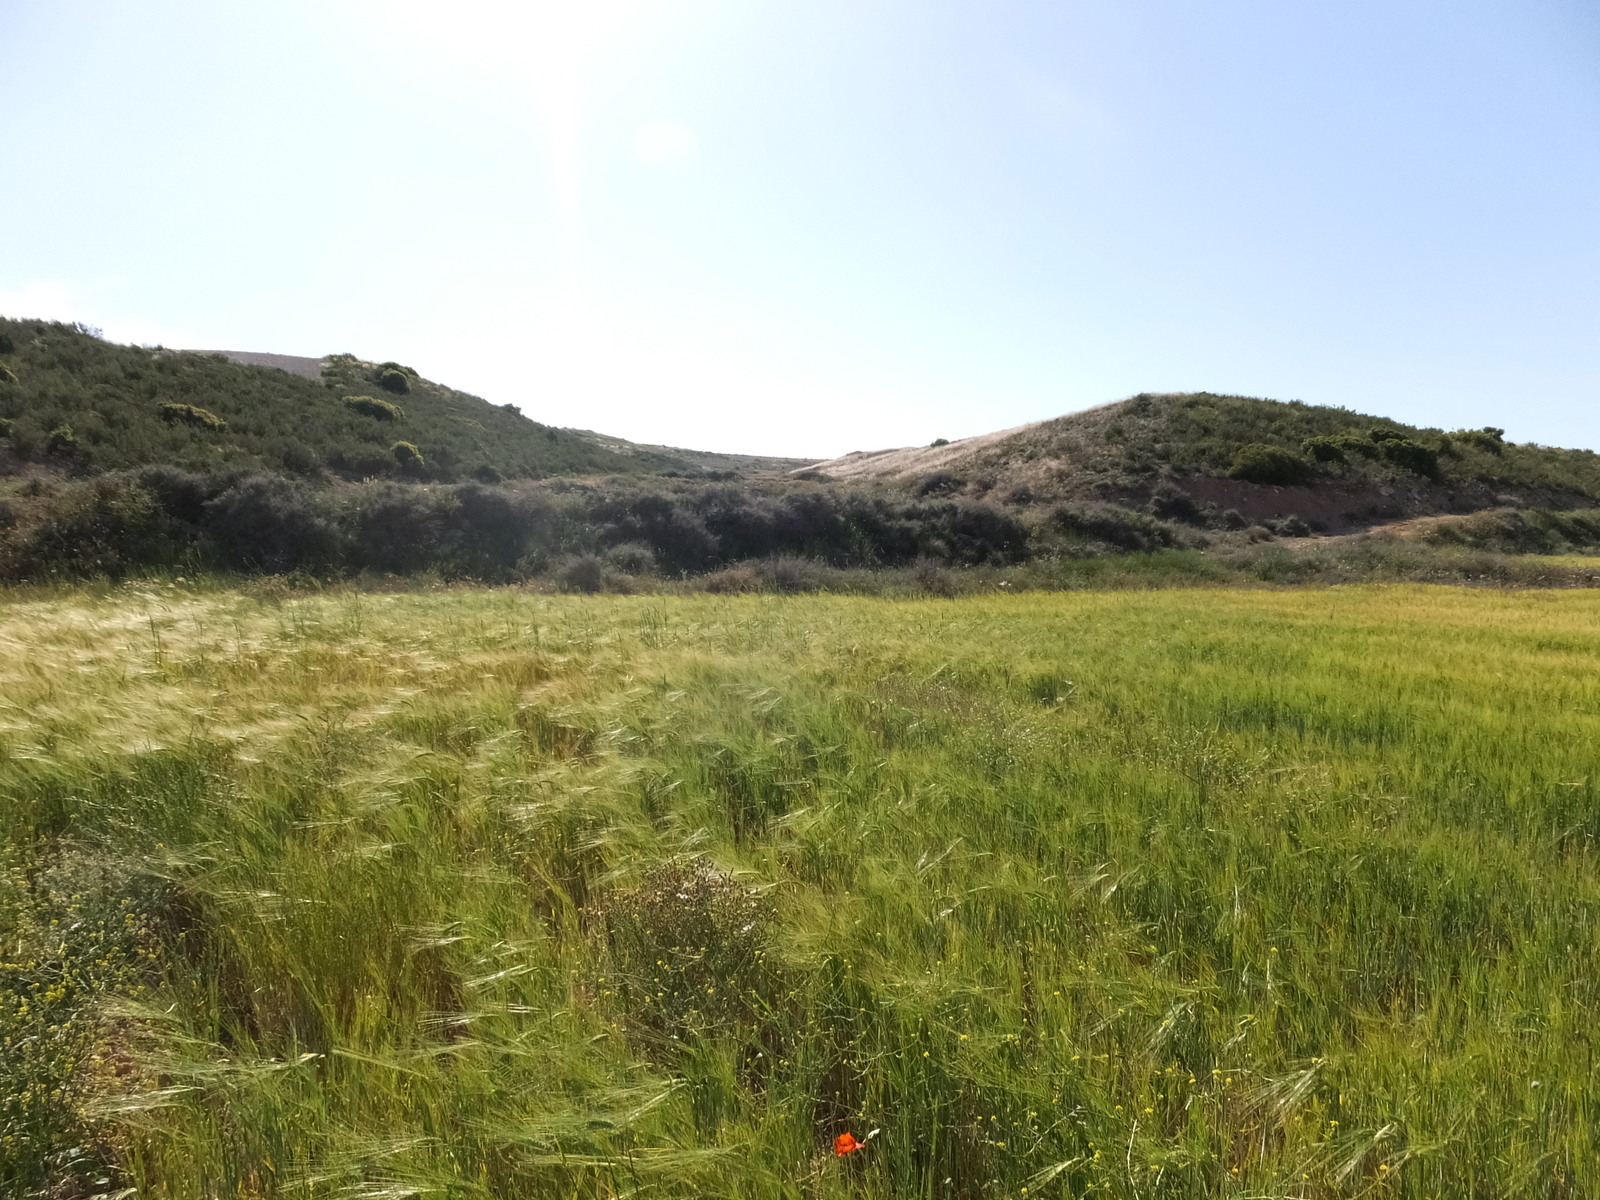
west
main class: Cropland
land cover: Barley
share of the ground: > 75 %
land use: Agriculture (excluding fallow land and kitchen gardens)
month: May
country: ES
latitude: 41.3624
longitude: -0.3078
